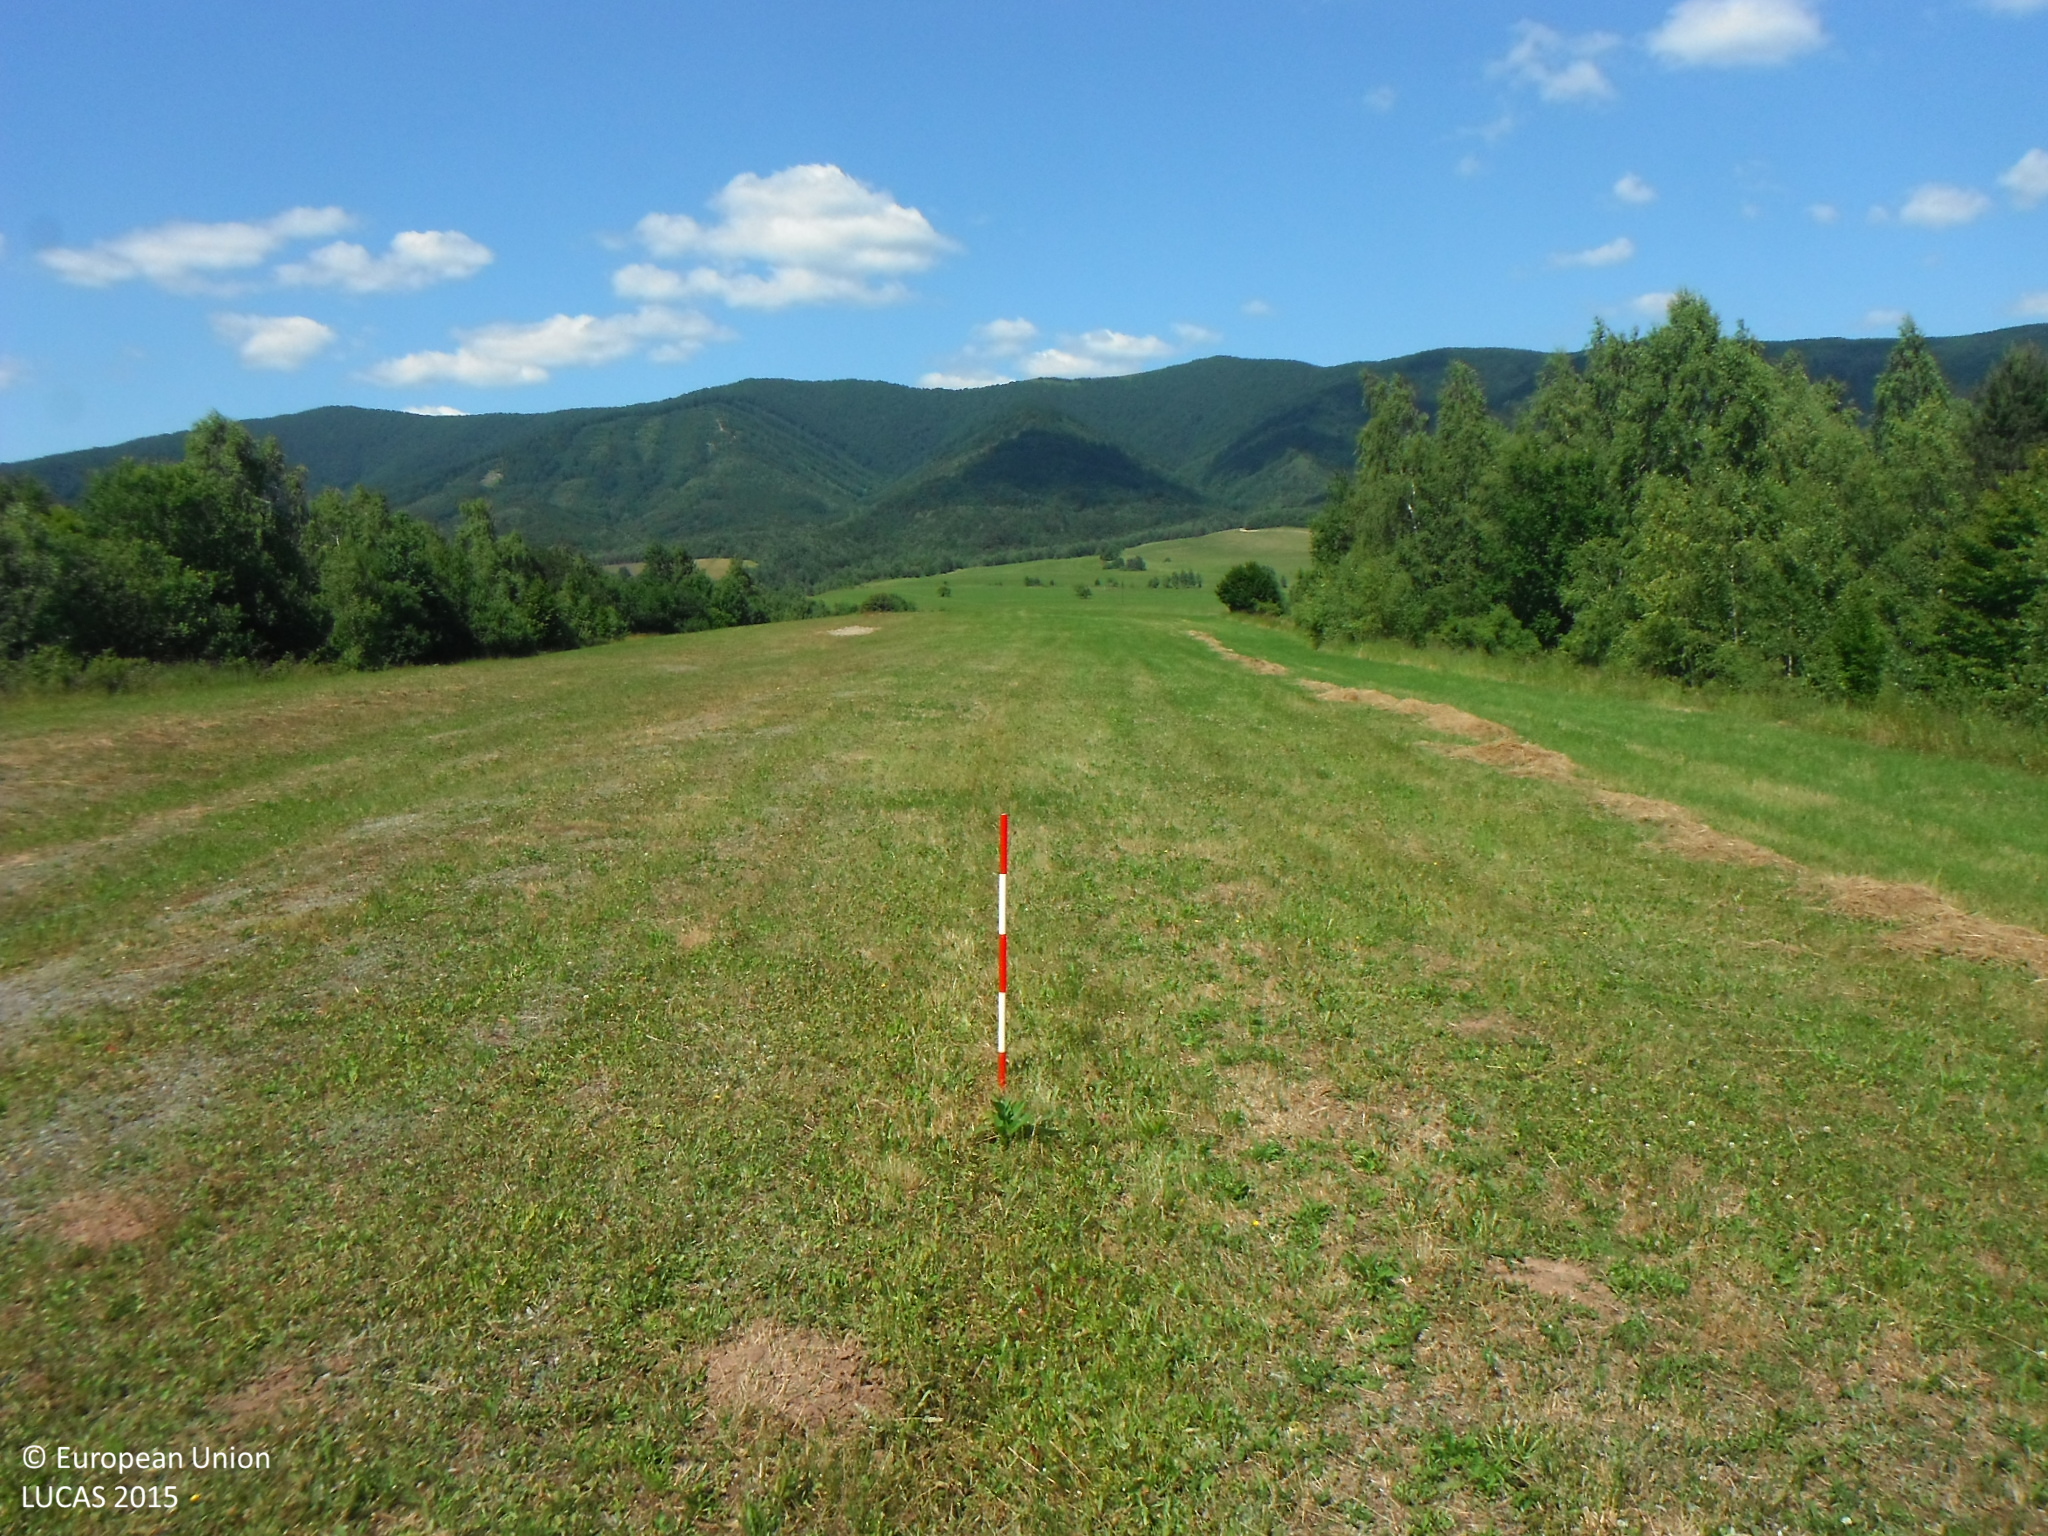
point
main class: Grassland
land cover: Grassland without tree/shrub cover
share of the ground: > 75 %
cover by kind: herbaceous plants 100 %
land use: Agriculture (excluding fallow land and kitchen gardens)
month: July
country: SK
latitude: 49.0680
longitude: 22.3942
